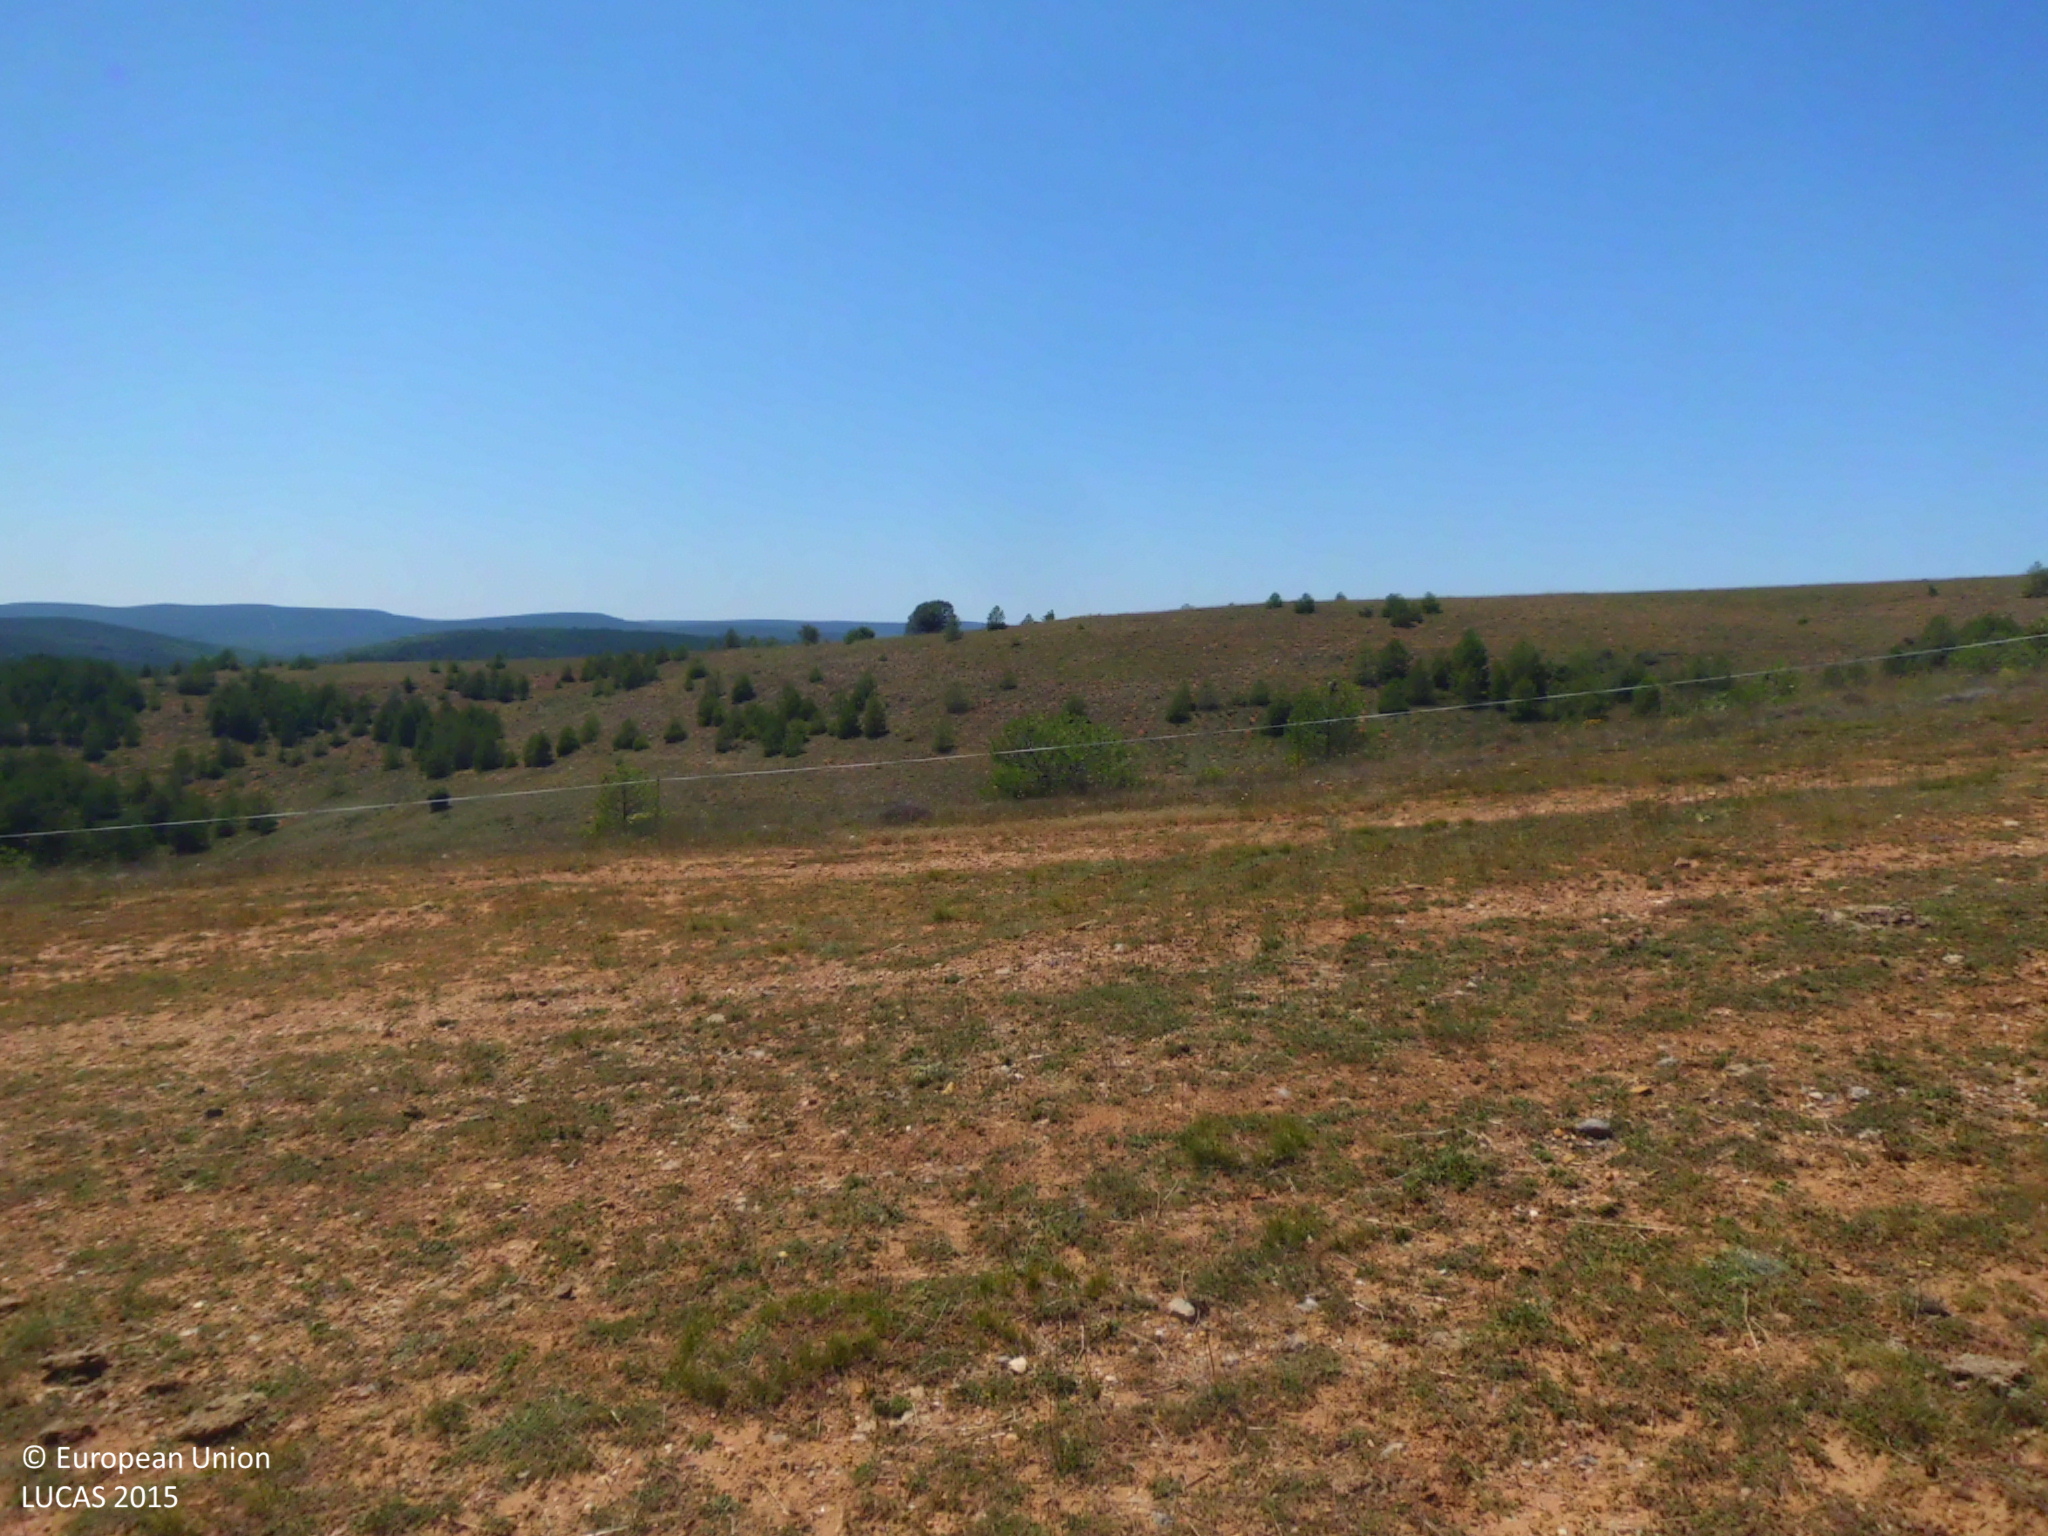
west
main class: Grassland
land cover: Spontaneously vegetated surfaces
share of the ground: 50 - 75 %
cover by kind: herbaceous plants 50 %, unconsolidated bare surface 50 %
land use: Fallow land
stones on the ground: > 50 %
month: June
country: ES
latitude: 42.7816
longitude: -5.0878
